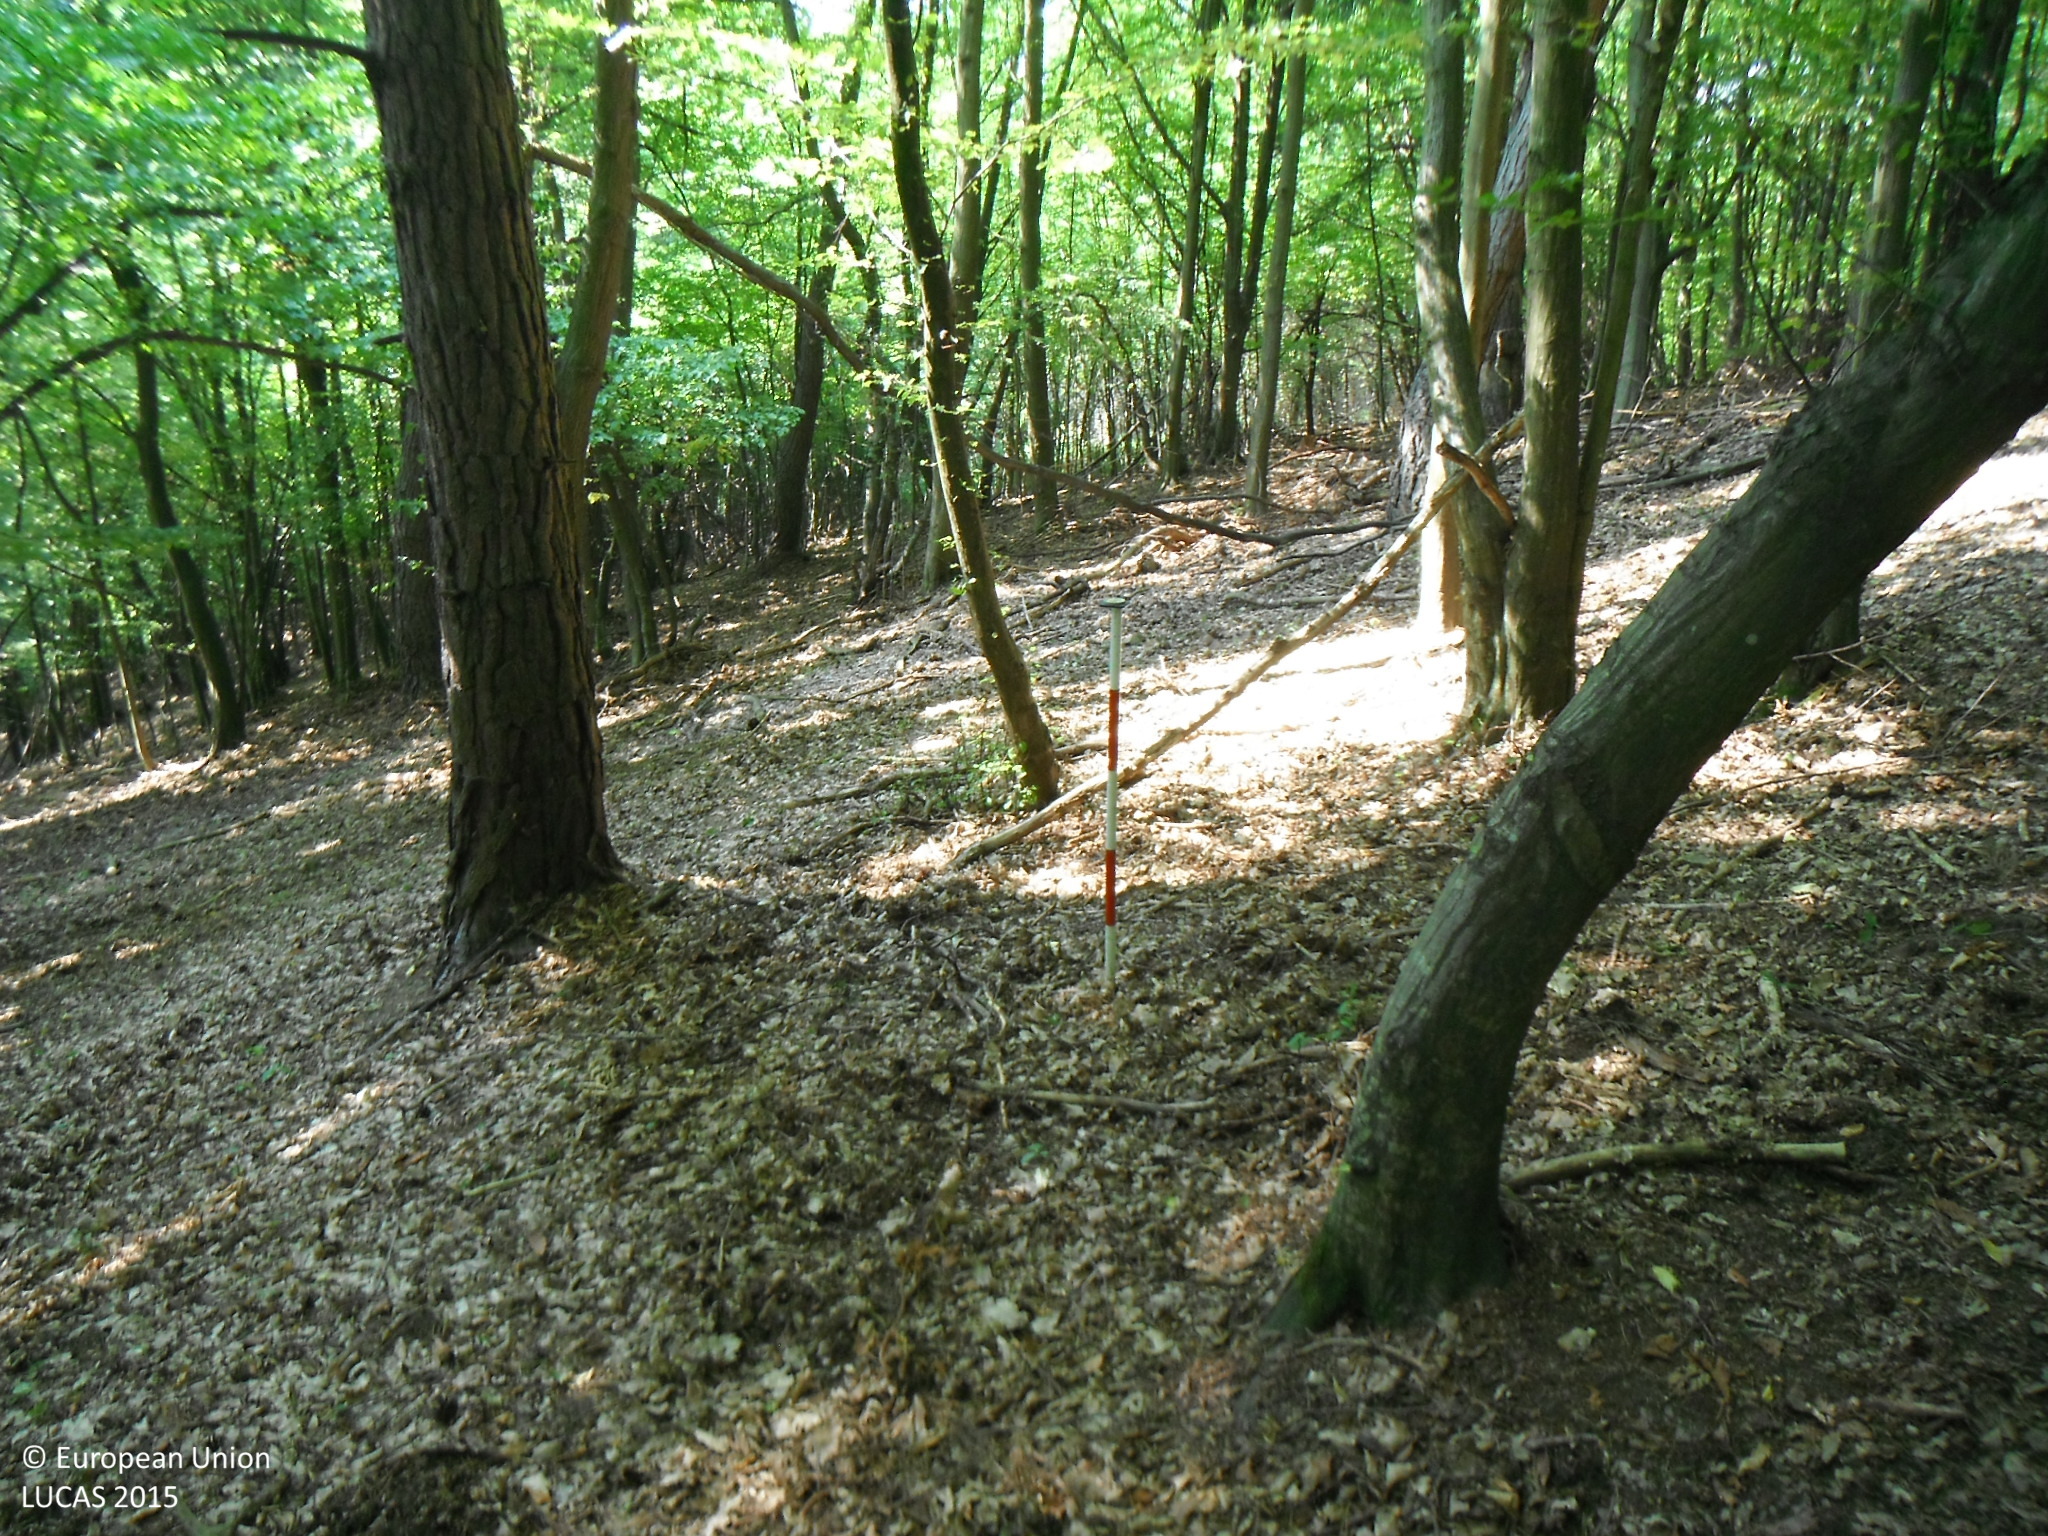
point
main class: Woodland
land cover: Pine dominated mixed woodland
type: mesophytic deciduous forest
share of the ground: > 75 %
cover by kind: broadleaved forest trees 60 %, coniferous forest trees 40 %
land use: Forestry
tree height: > 5 m
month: August
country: SK
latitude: 49.1770
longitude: 18.2883
